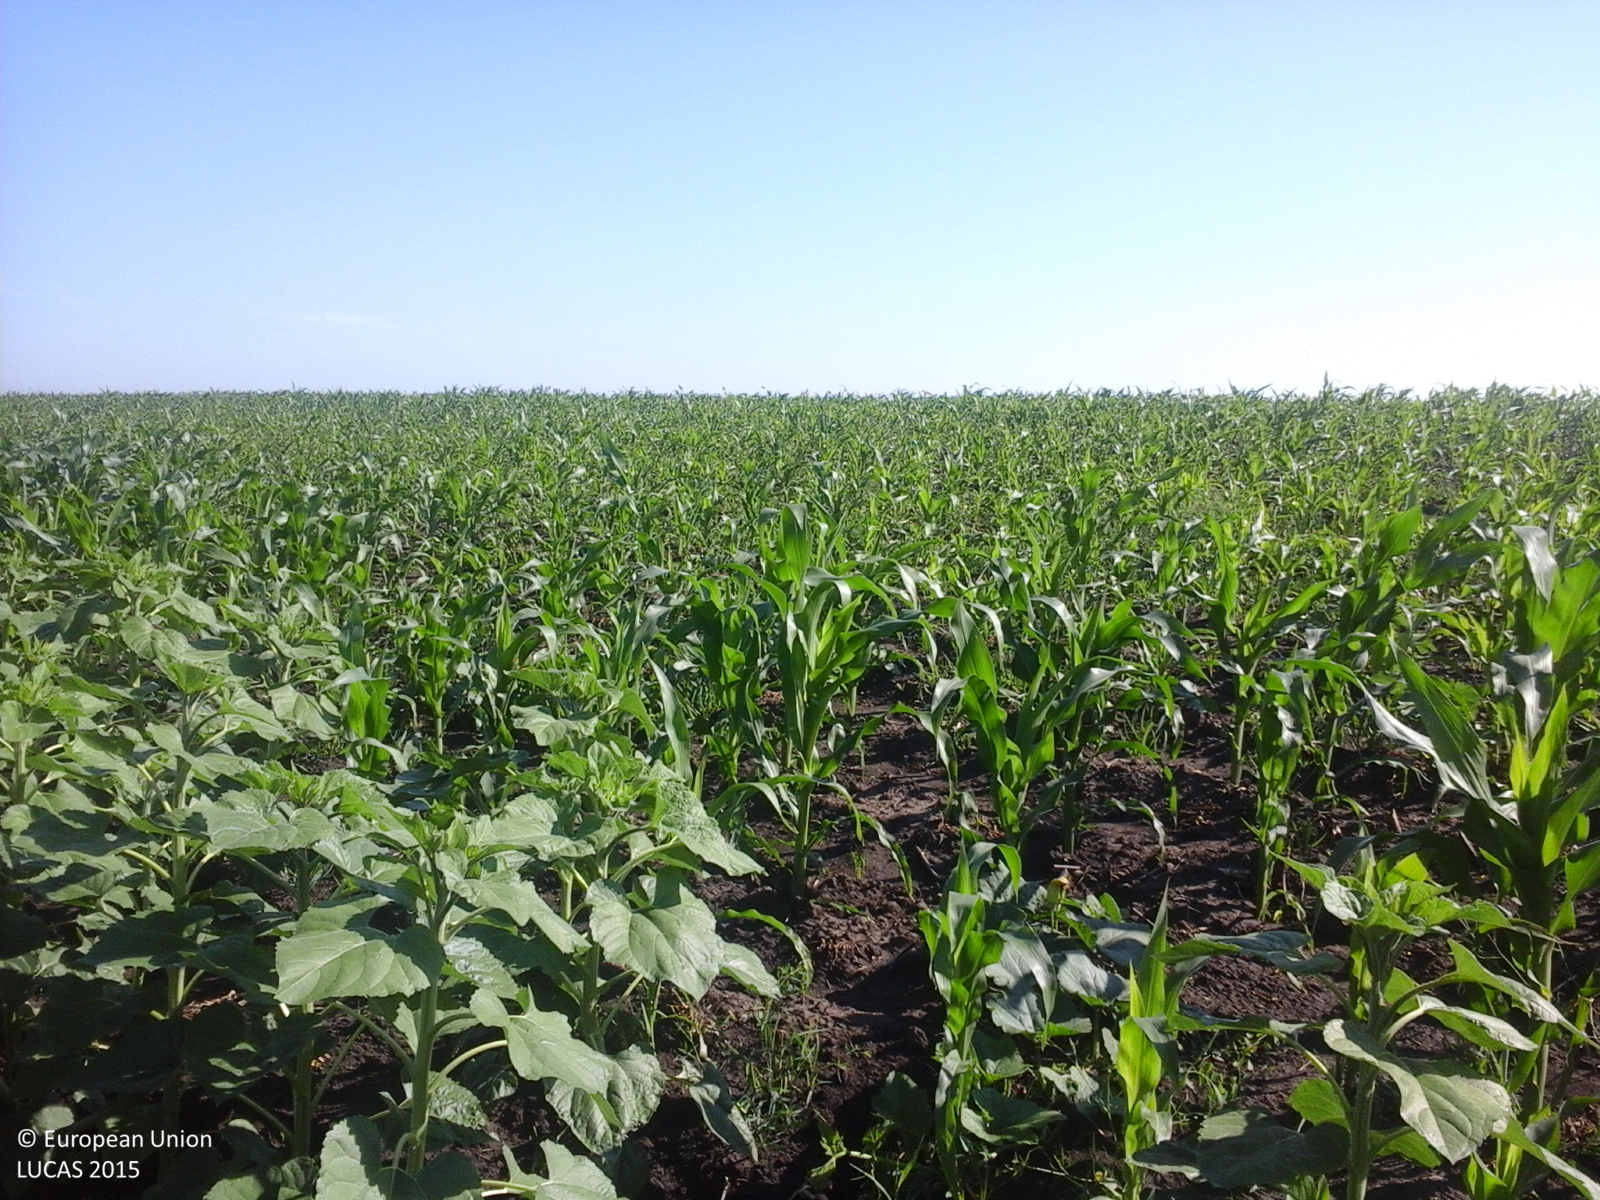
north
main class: Cropland
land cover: Sunflower
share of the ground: 50 - 75 %
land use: Agriculture (excluding fallow land and kitchen gardens)
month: June
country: RO
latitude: 47.7020
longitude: 27.0984
